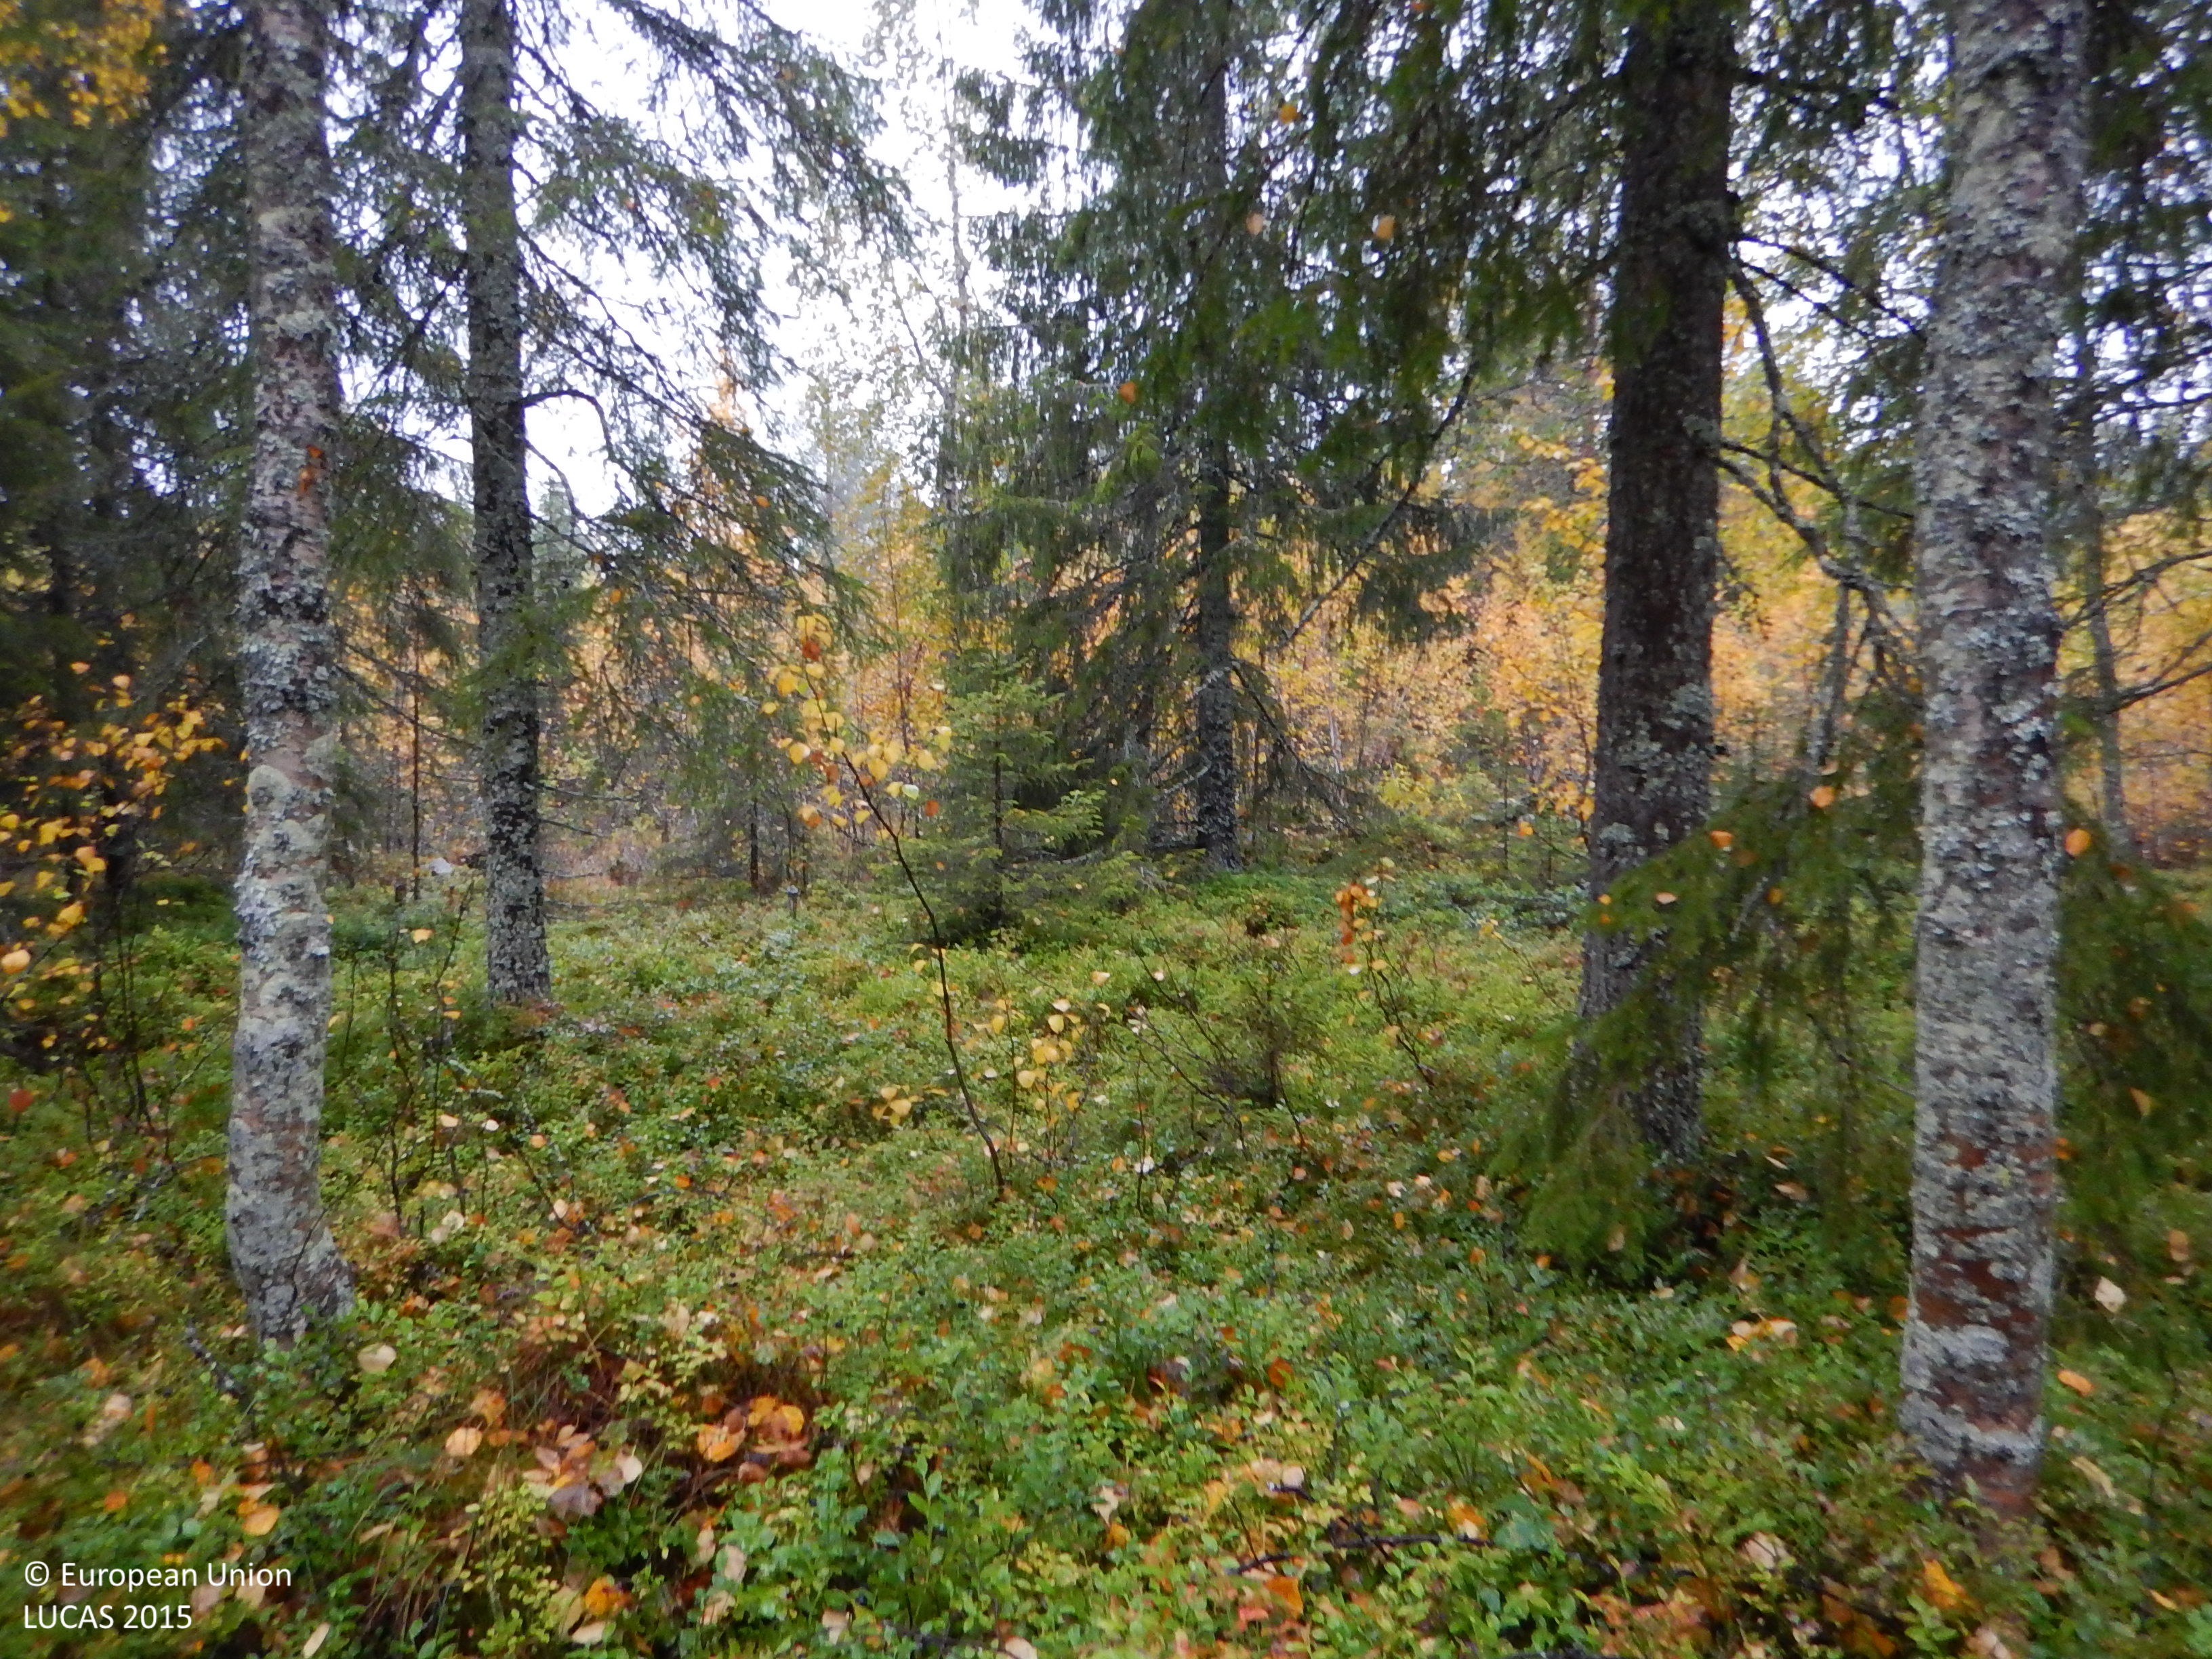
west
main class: Woodland
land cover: Spruce dominated mixed woodland
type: boreal forest
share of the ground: 25 - 50 %
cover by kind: coniferous forest trees 30 %, herbaceous plants 20 %, lichens and mosses 20 %, broadleaved forest trees 15 %, shrubs 15 %
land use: Forestry
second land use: Amenities, museums, leisure
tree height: > 5 m
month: September
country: SE
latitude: 65.0324
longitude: 19.0314
